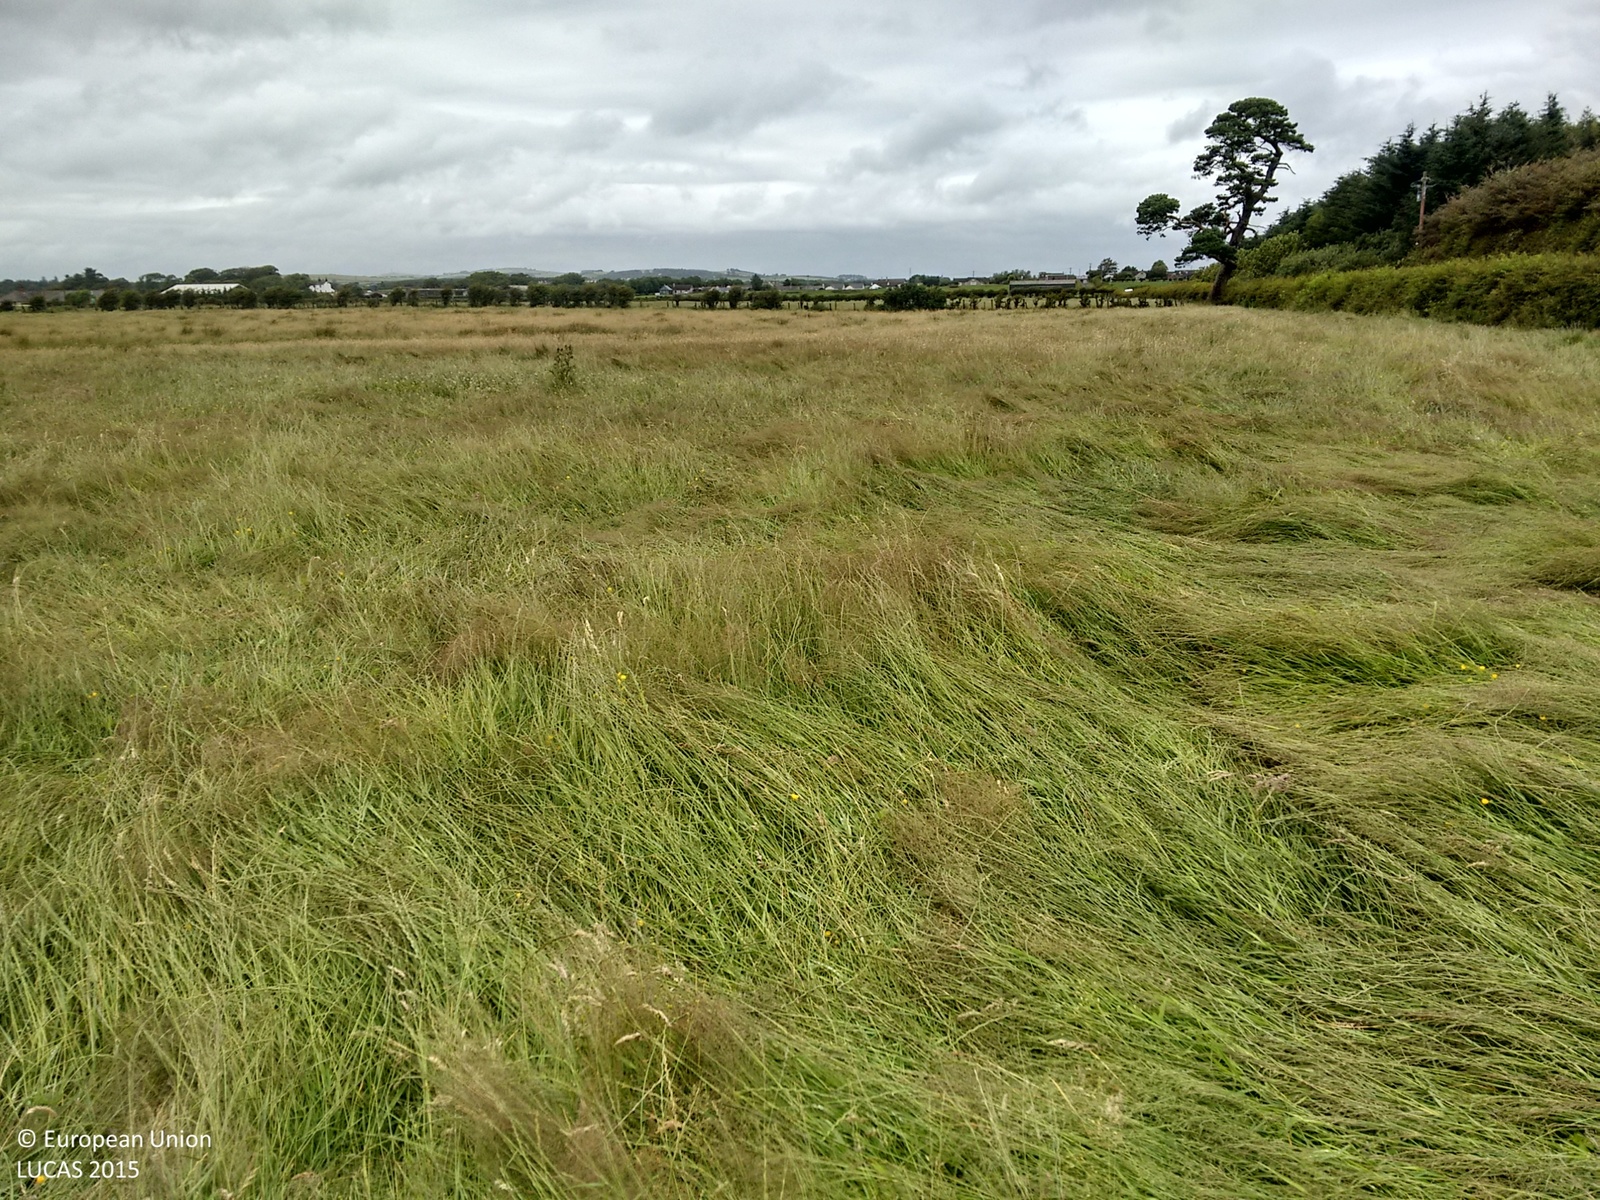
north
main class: Grassland
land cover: Grassland without tree/shrub cover
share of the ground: > 75 %
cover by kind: herbaceous plants 100 %
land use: Agriculture (excluding fallow land and kitchen gardens)
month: July
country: GB
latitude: 54.9868
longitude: -3.4095
